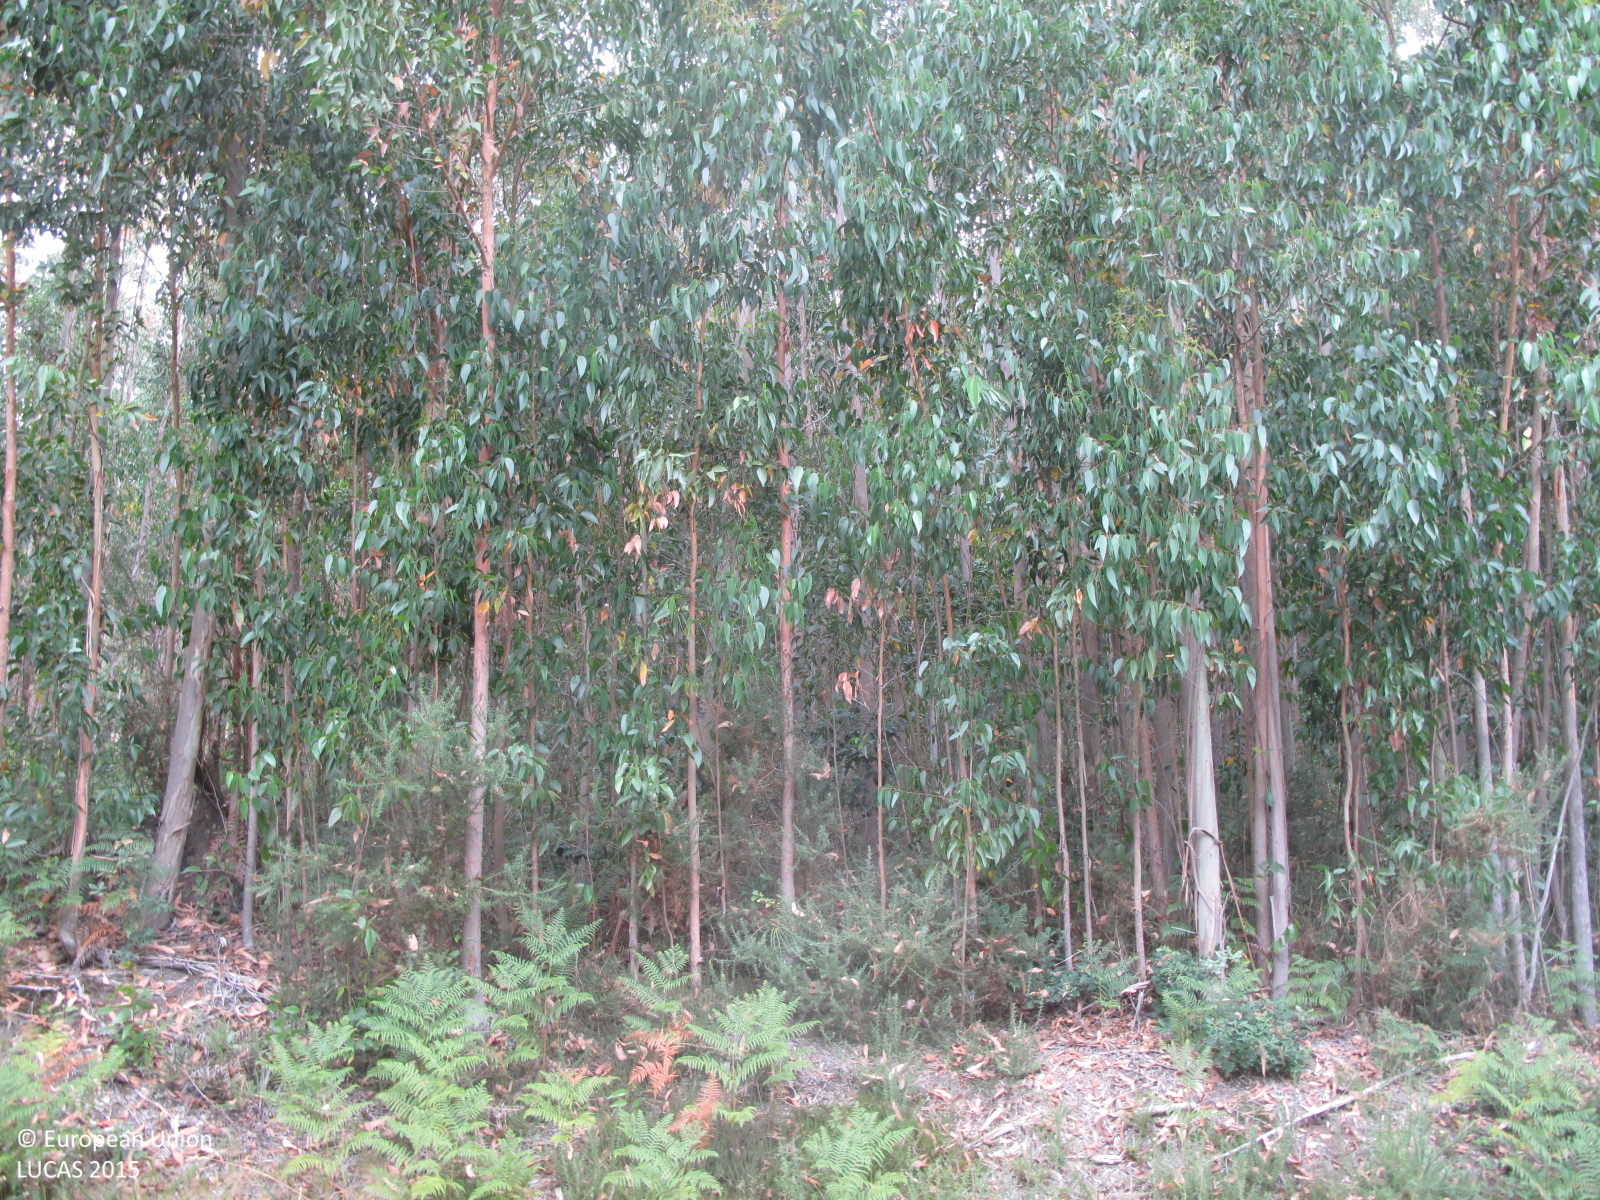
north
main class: Woodland
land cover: Broadleaved woodland
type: exotic forest
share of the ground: 50 - 75 %
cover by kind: broadleaved forest trees 60 %, herbaceous plants 20 %, shrubs 10 %, unconsolidated bare surface 10 %
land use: Forestry
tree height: > 5 m
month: July
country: ES
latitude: 43.2645
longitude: -8.0697
